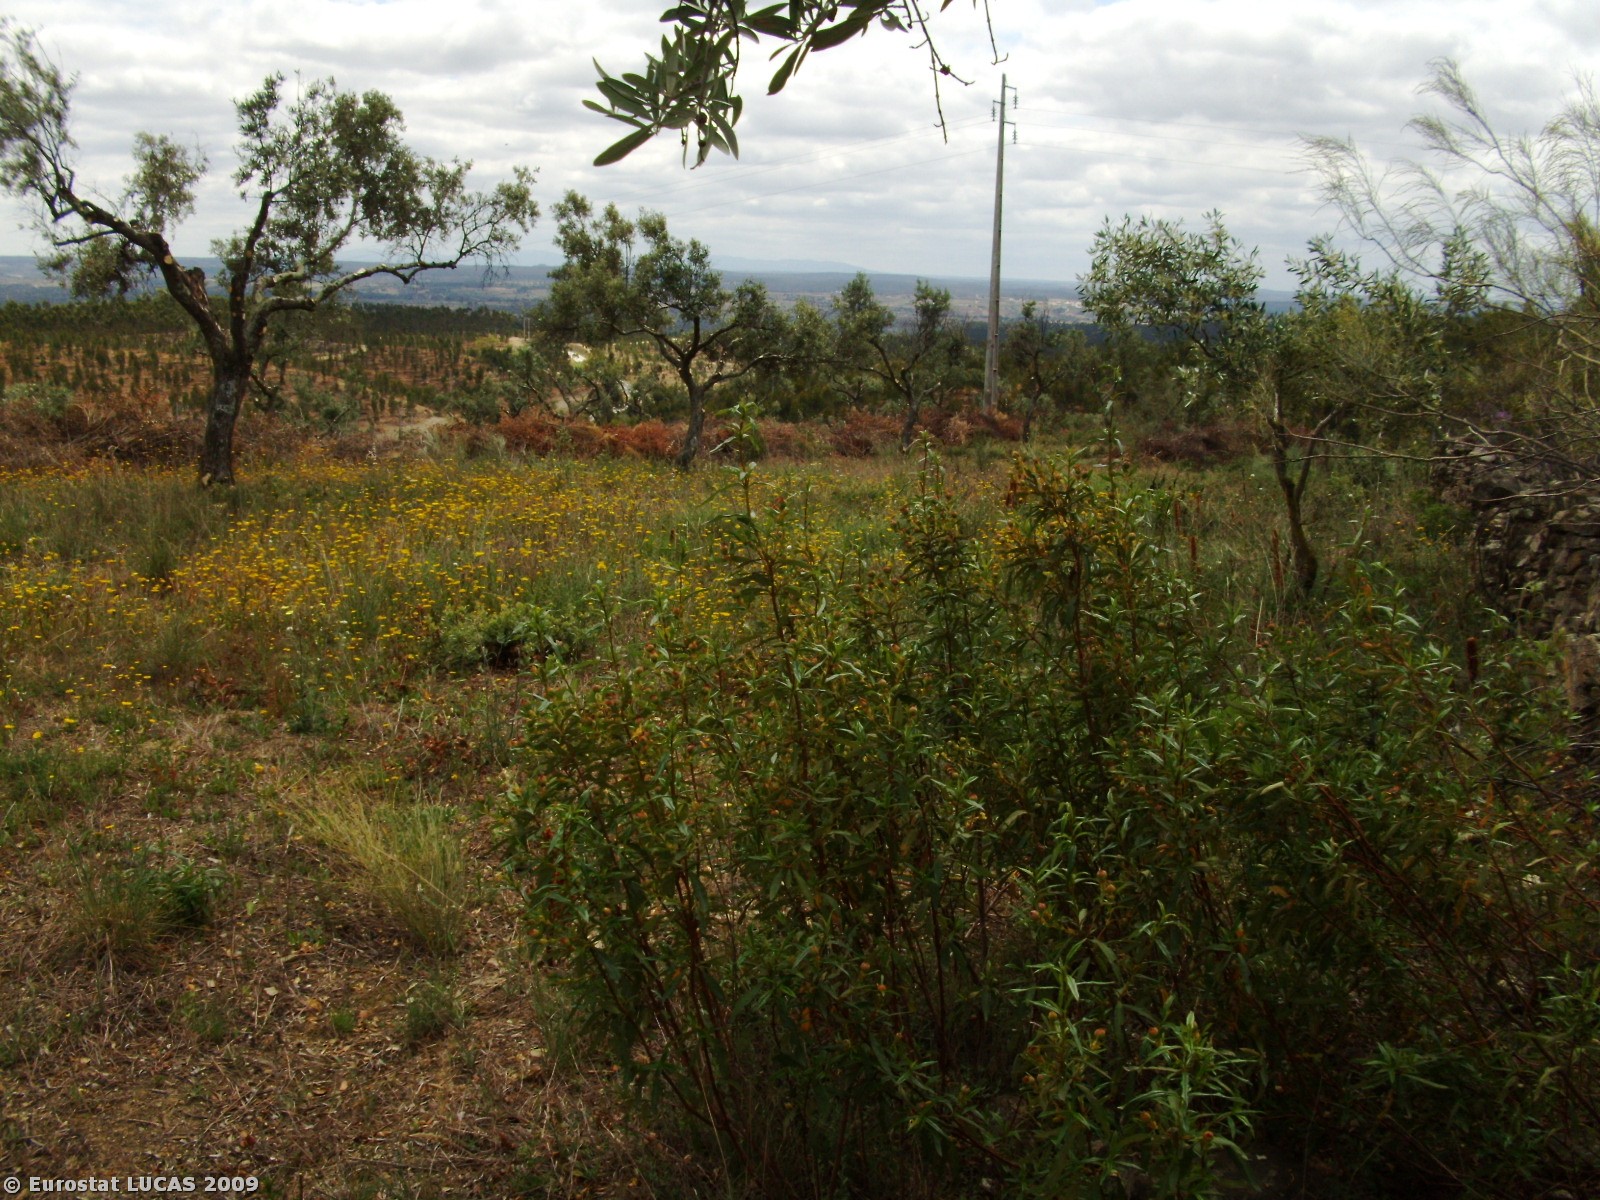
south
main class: Cropland
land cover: Olive groves
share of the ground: 25 - 50 %
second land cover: Spontaneously vegetated surfaces
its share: 50 - 75 %
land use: Agriculture (excluding fallow land and kitchen gardens)
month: April
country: PT
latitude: 39.7948
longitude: -7.4636
